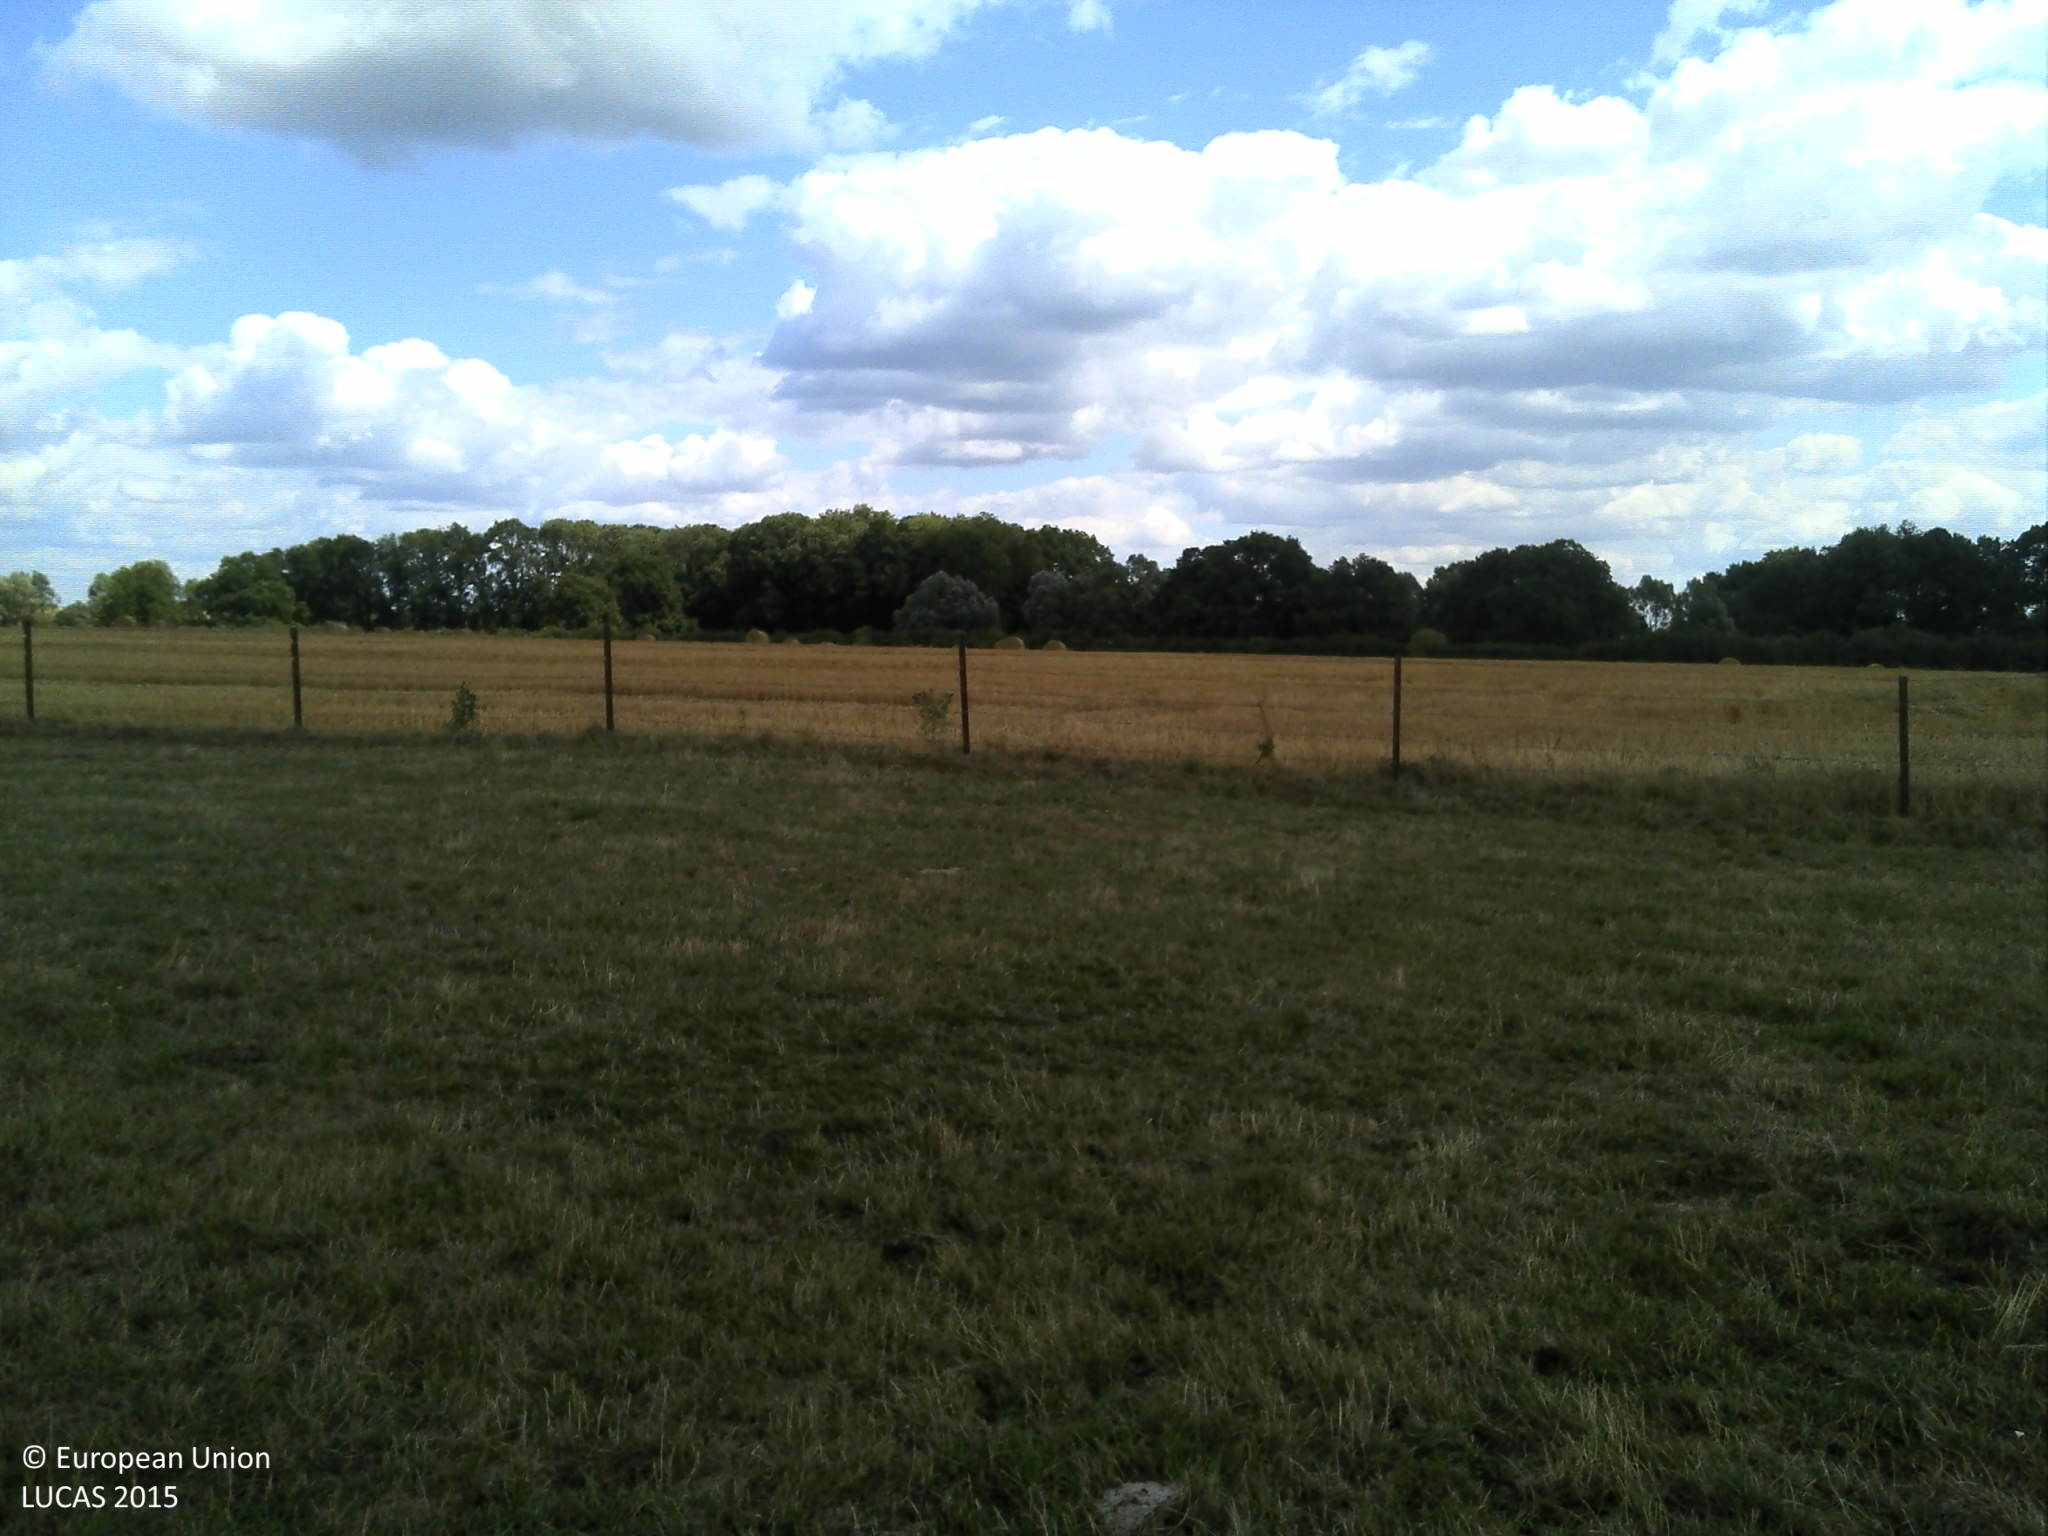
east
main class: Grassland
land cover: Grassland without tree/shrub cover
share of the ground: > 75 %
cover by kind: herbaceous plants 100 %
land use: Agriculture (excluding fallow land and kitchen gardens)
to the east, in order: Grassland without tree/shrub cover; Fences; Common wheat; Barley; Lucerne
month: July
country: FR
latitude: 49.3566
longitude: 4.6687
